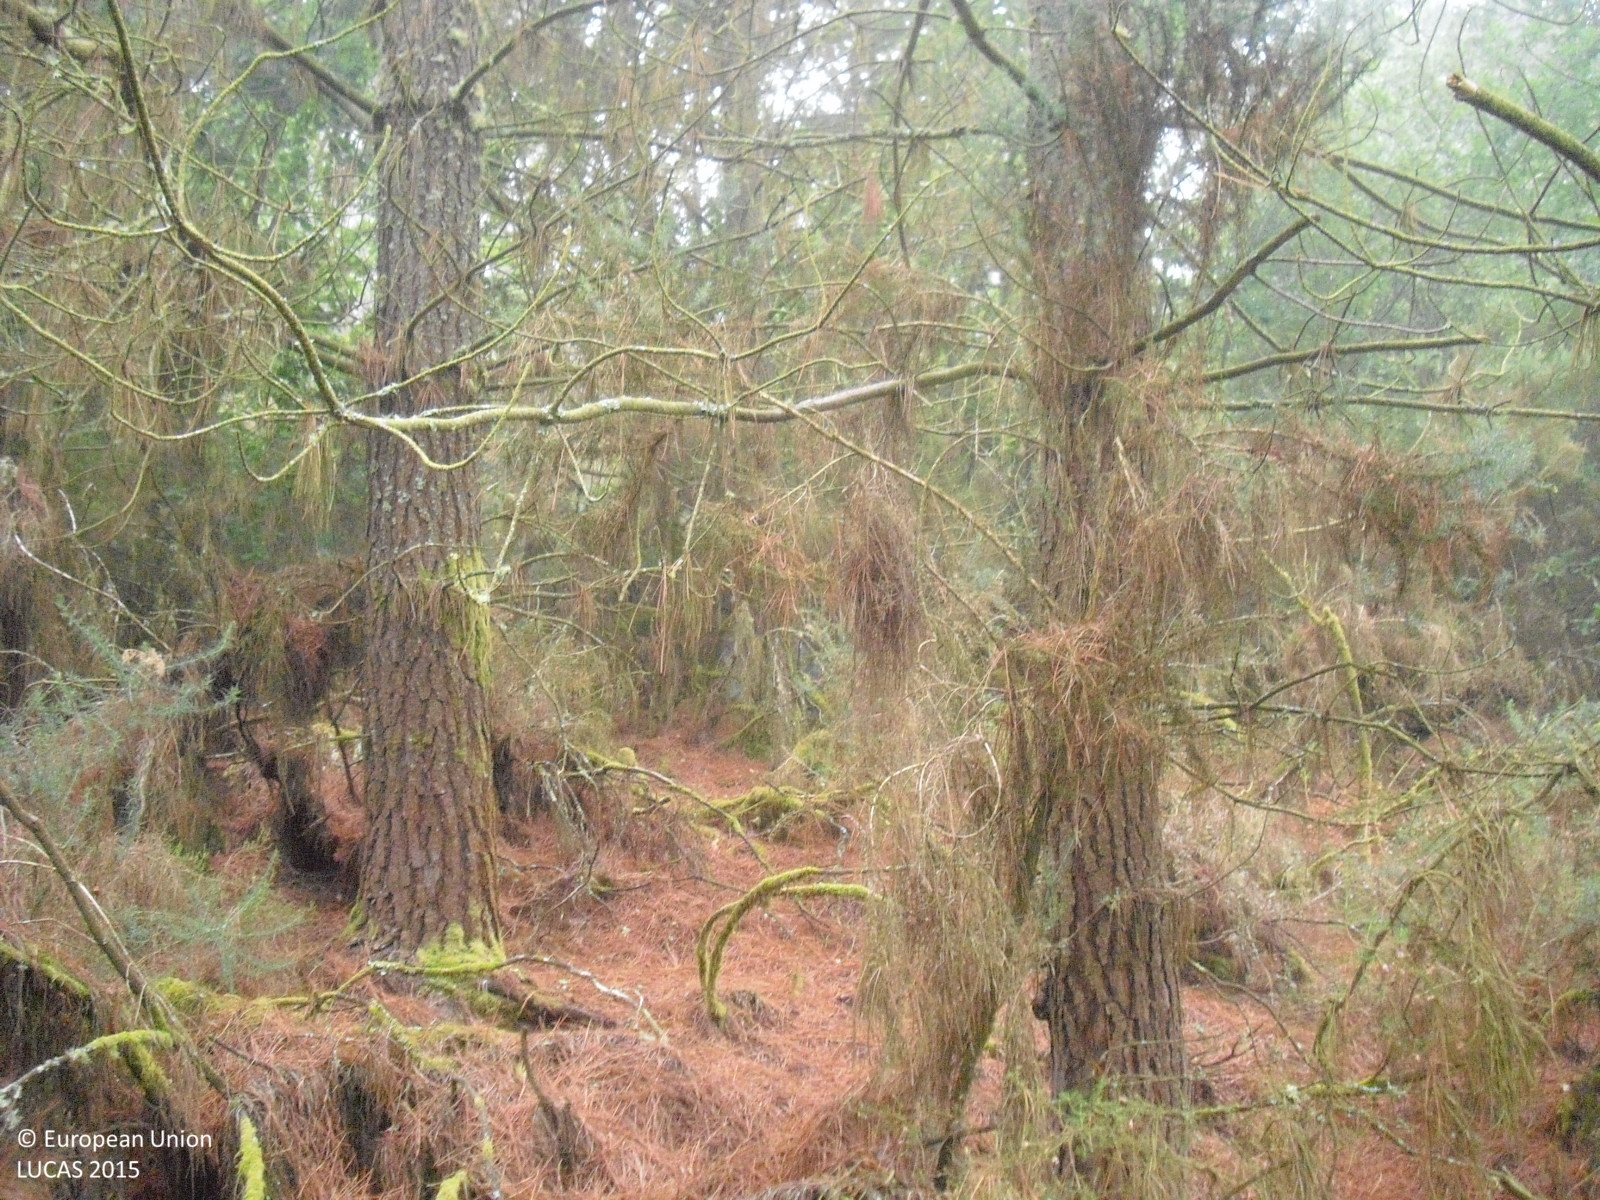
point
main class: Woodland
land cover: Pine dominated mixed woodland
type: hemiboreal forest and nemoral coniferous forest and mixed broadleaved-coniferous forest
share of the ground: 50 - 75 %
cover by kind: coniferous forest trees 40 %, broadleaved forest trees 30 %, shrubs 30 %
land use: Forestry
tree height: > 5 m
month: June
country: ES
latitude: 42.6795
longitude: -7.9375
